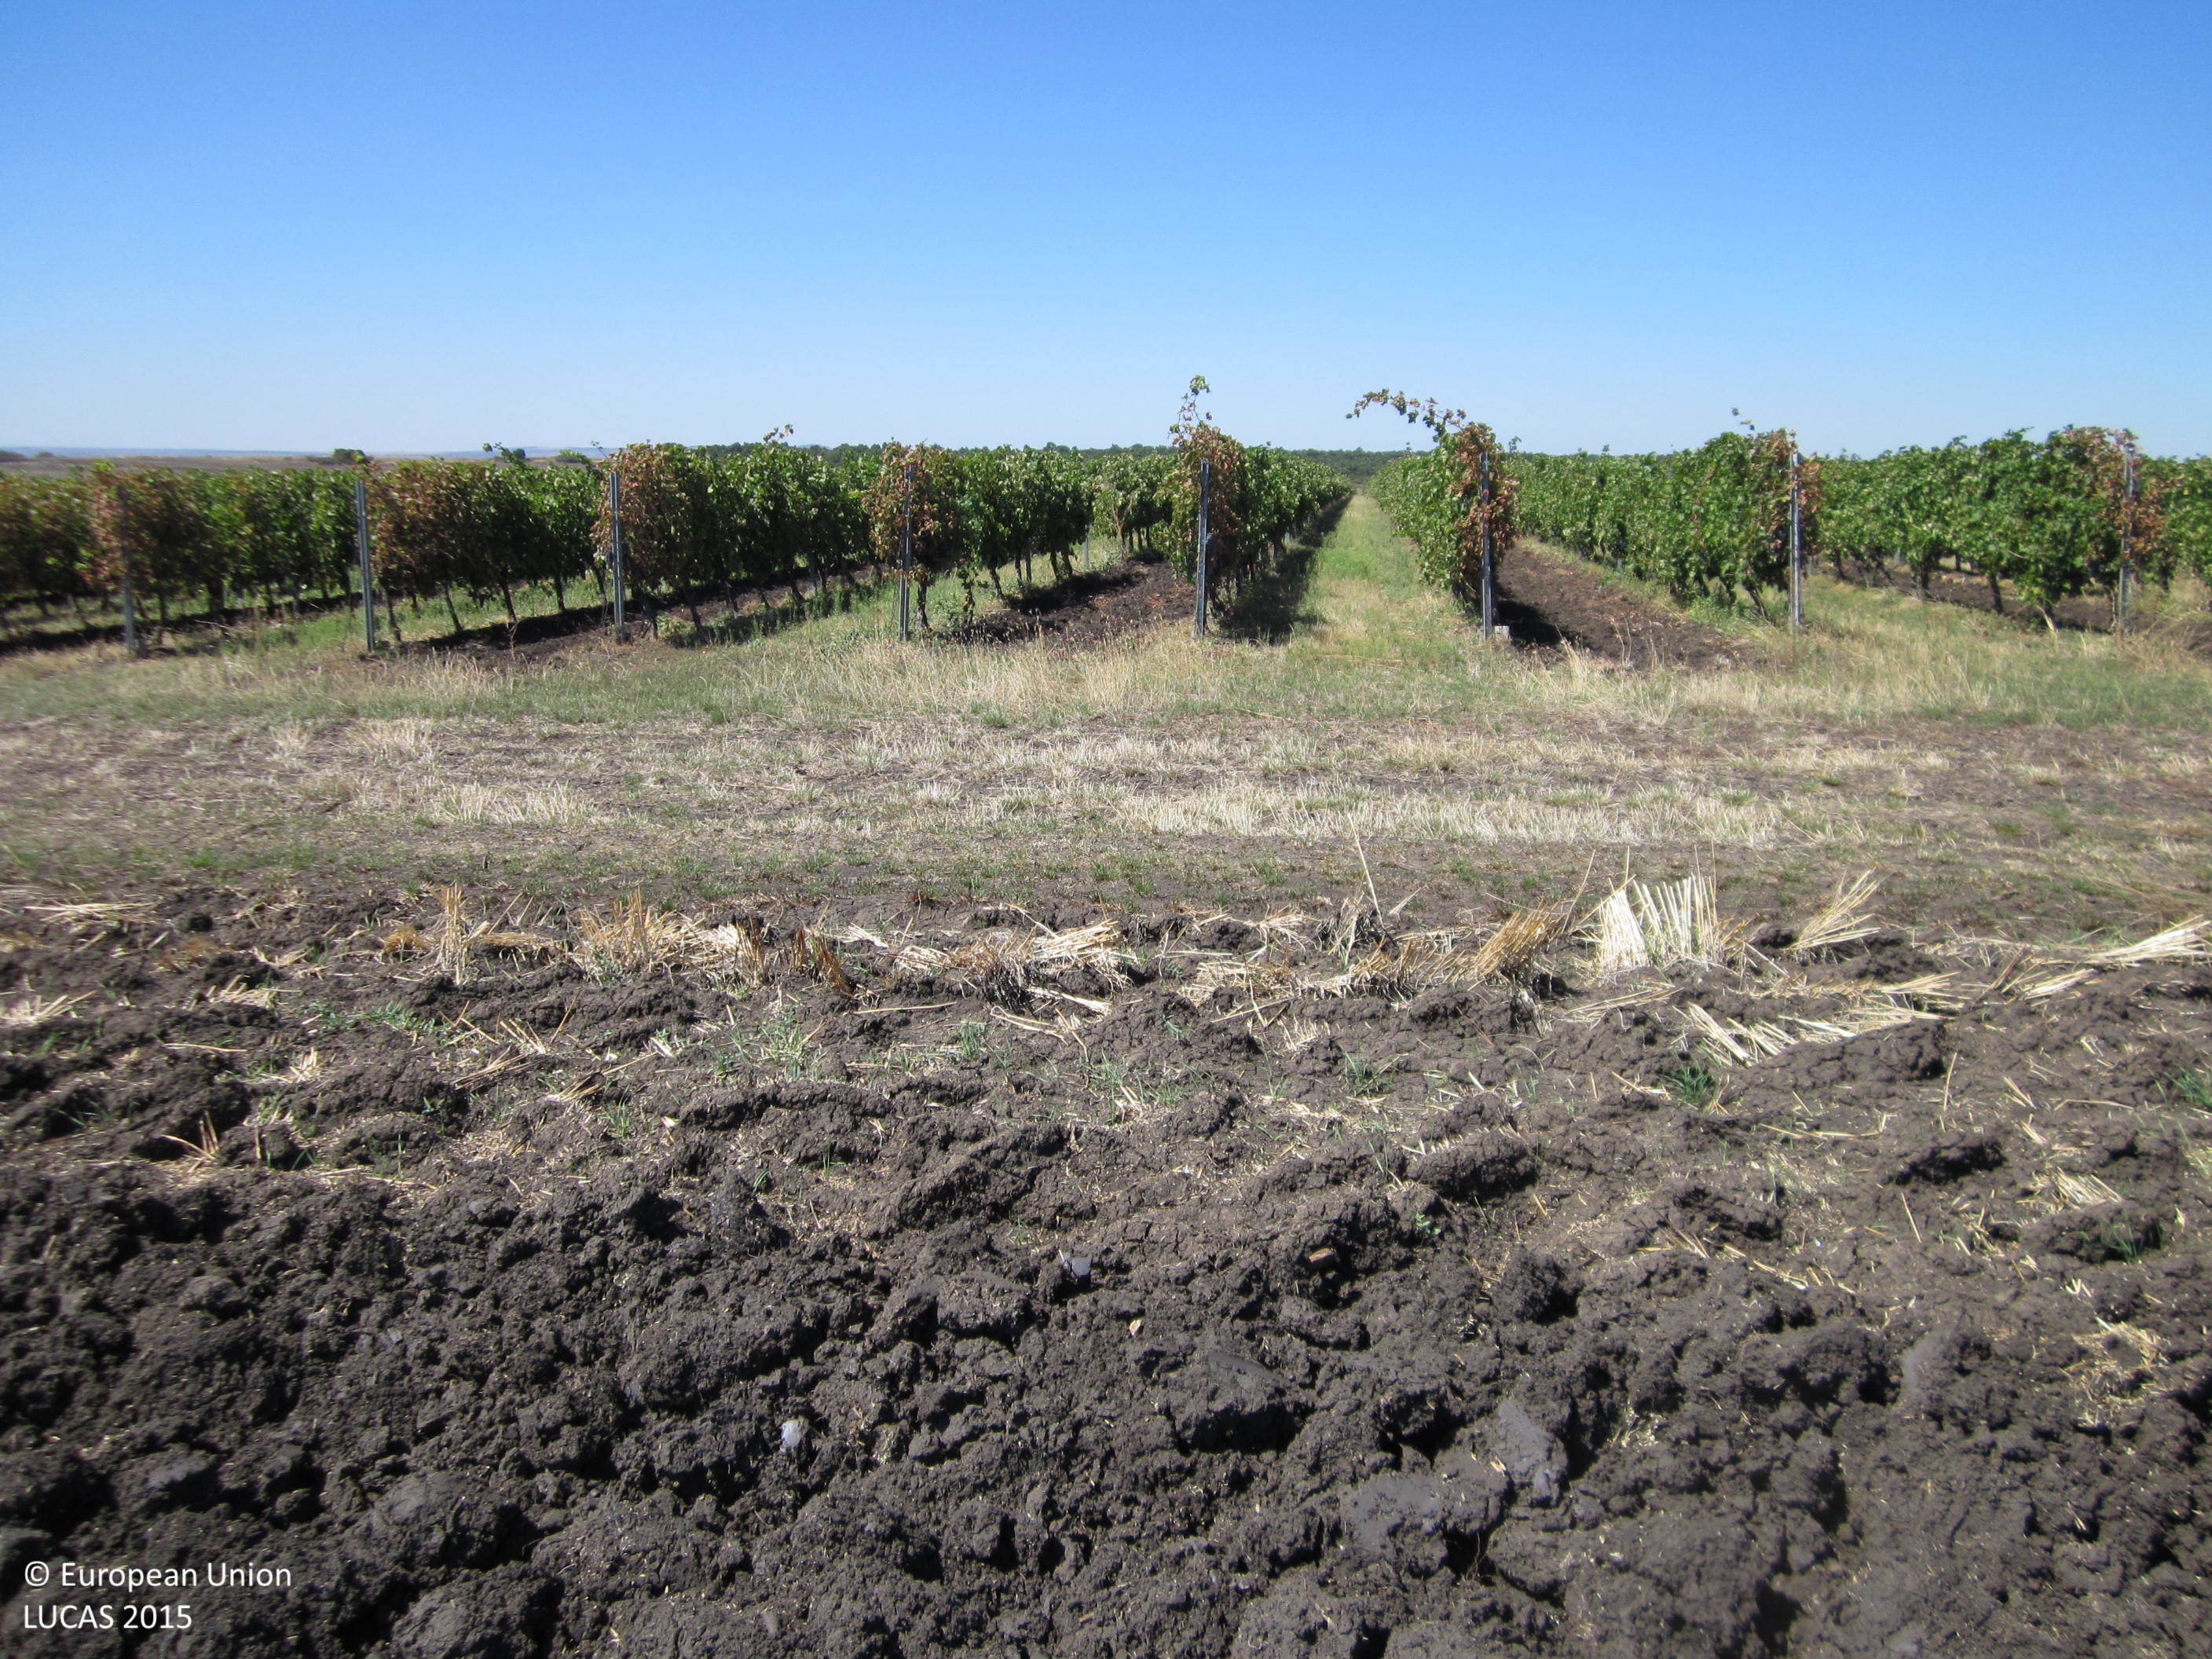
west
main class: Cropland
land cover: Common wheat
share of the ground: < 10 %
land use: Agriculture (excluding fallow land and kitchen gardens)
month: September
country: BG
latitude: 42.5331
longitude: 27.0915
